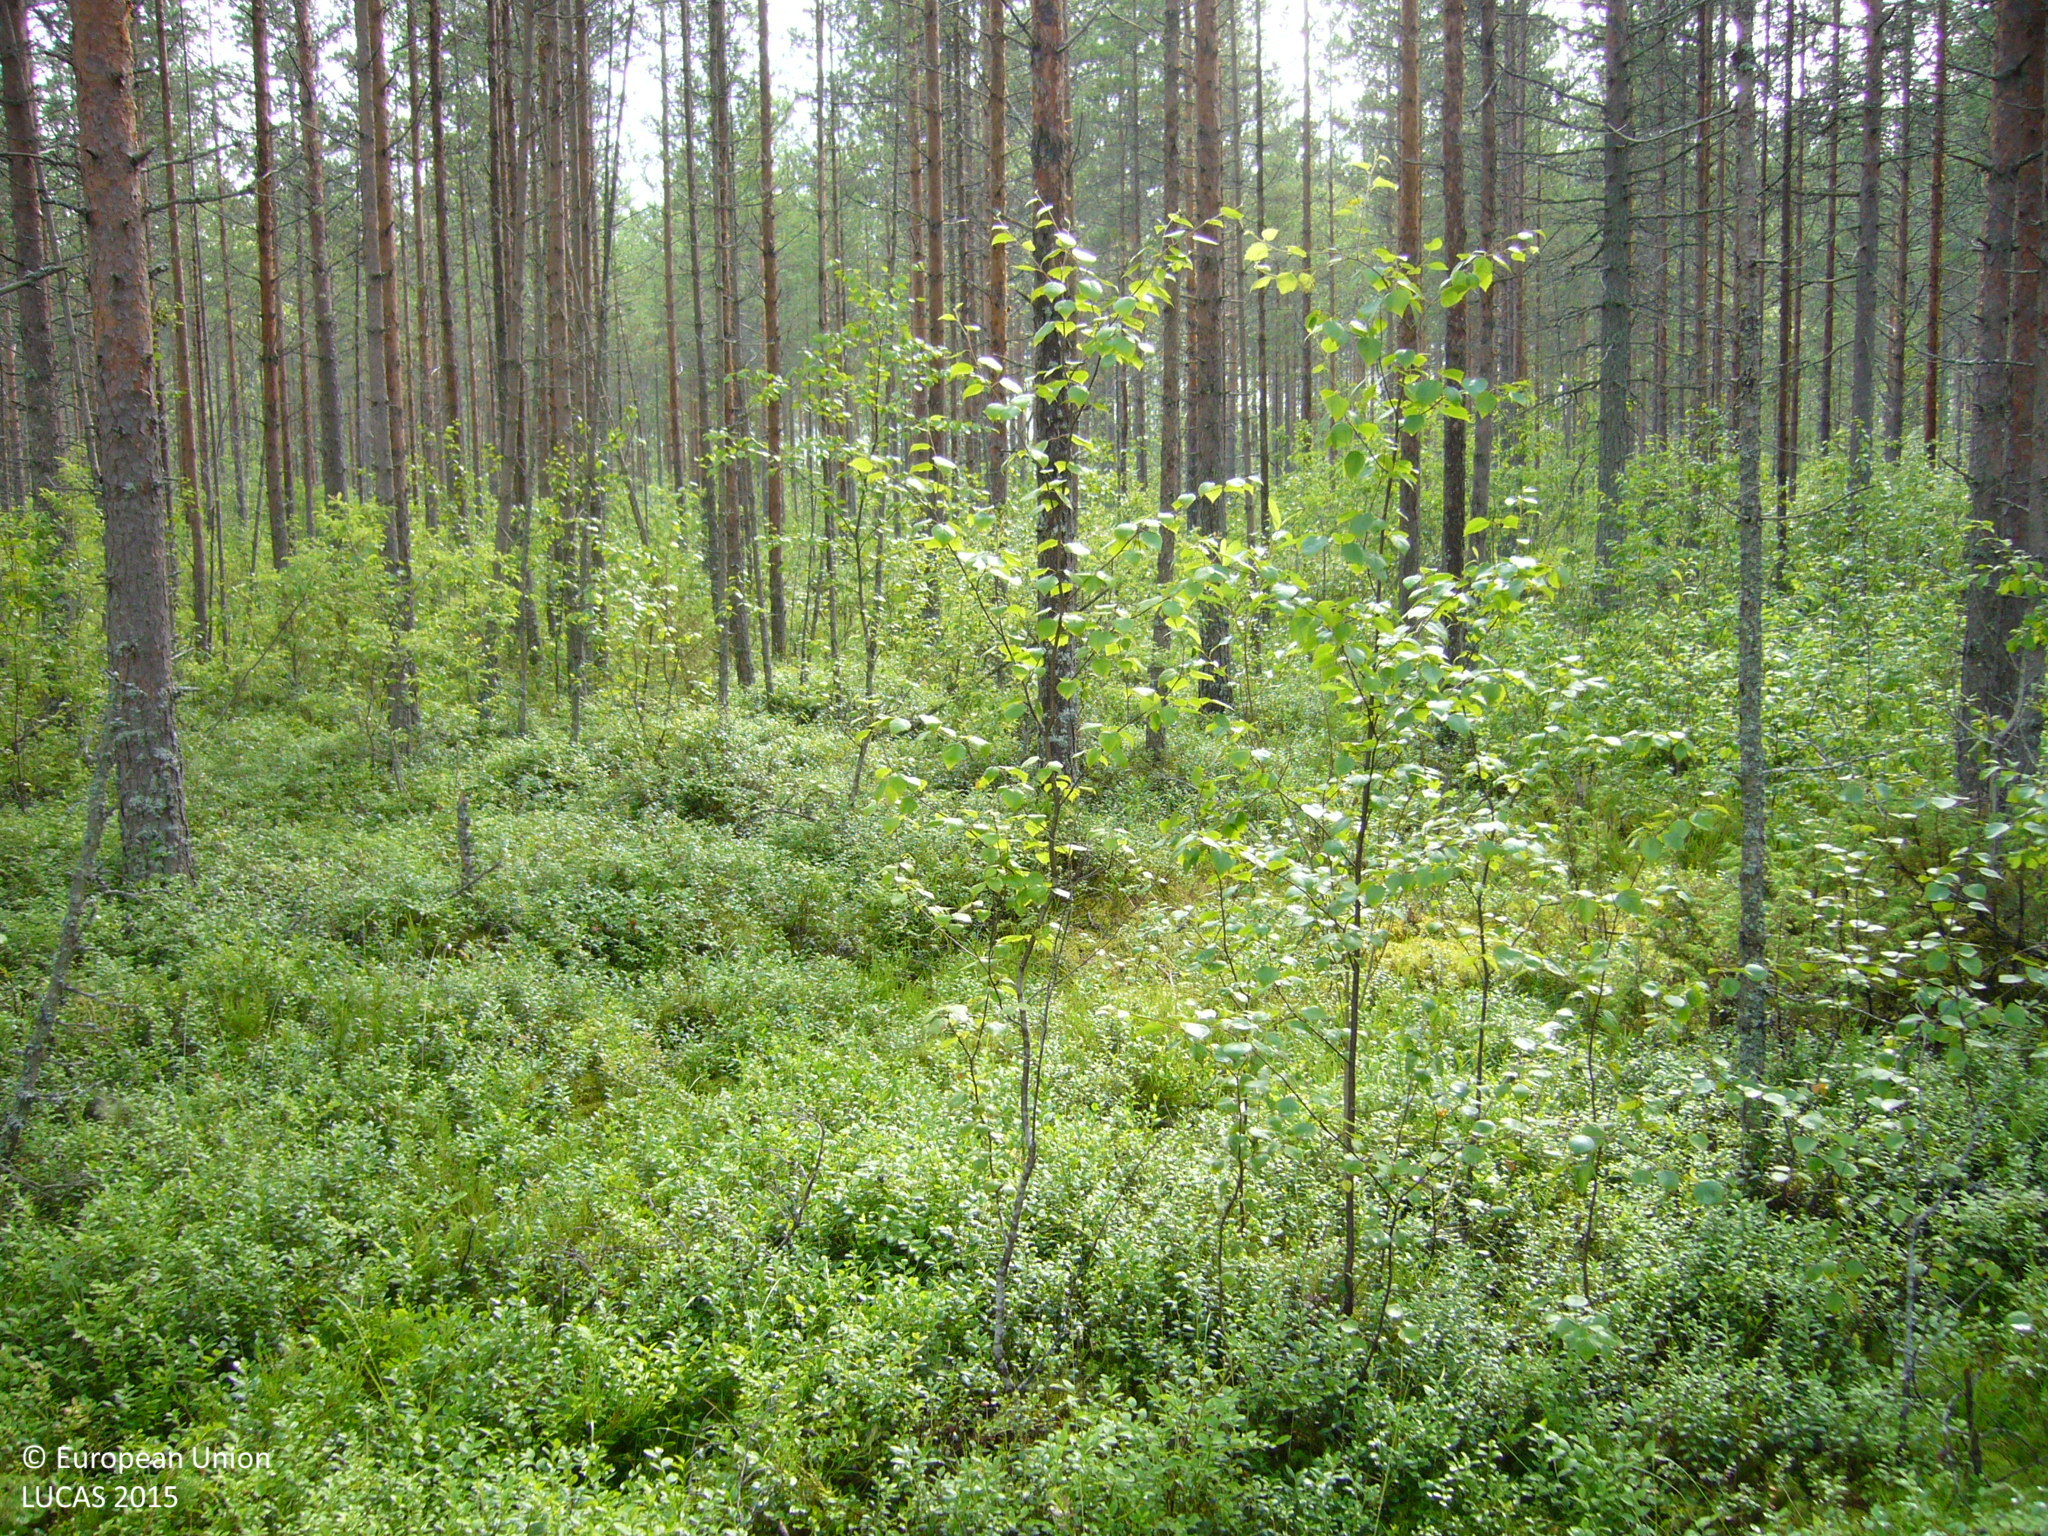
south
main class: Woodland
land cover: Pine dominated mixed woodland
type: boreal forest
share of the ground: > 75 %
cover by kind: coniferous forest trees 50 %, broadleaved forest trees 30 %, shrubs 20 %
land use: Forestry
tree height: > 5 m
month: July
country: FI
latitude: 63.9723
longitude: 25.7689
